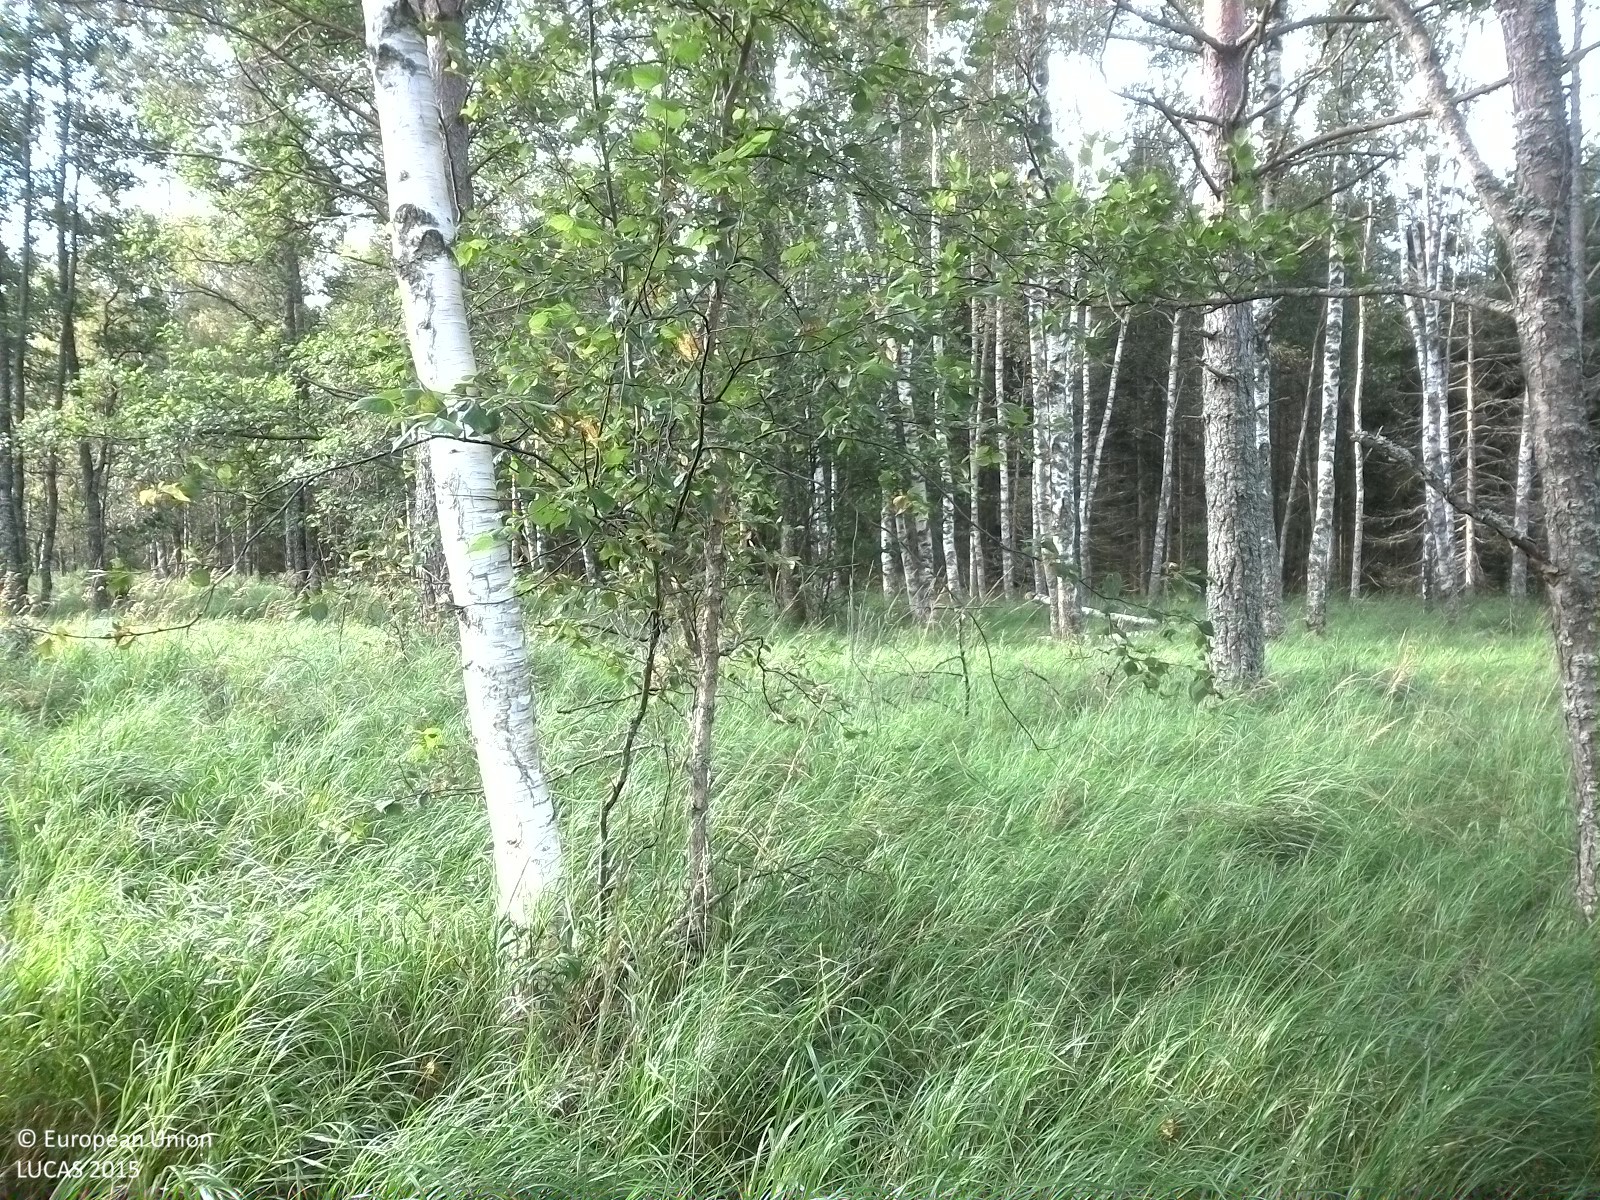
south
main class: Woodland
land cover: Pine dominated mixed woodland
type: boreal forest
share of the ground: 10 - 25 %
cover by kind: herbaceous plants 80 %, coniferous forest trees 15 %, broadleaved forest trees 5 %
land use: Semi-natural and natural areas not in use
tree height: > 5 m
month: August
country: SE
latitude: 58.8484
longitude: 15.4524
